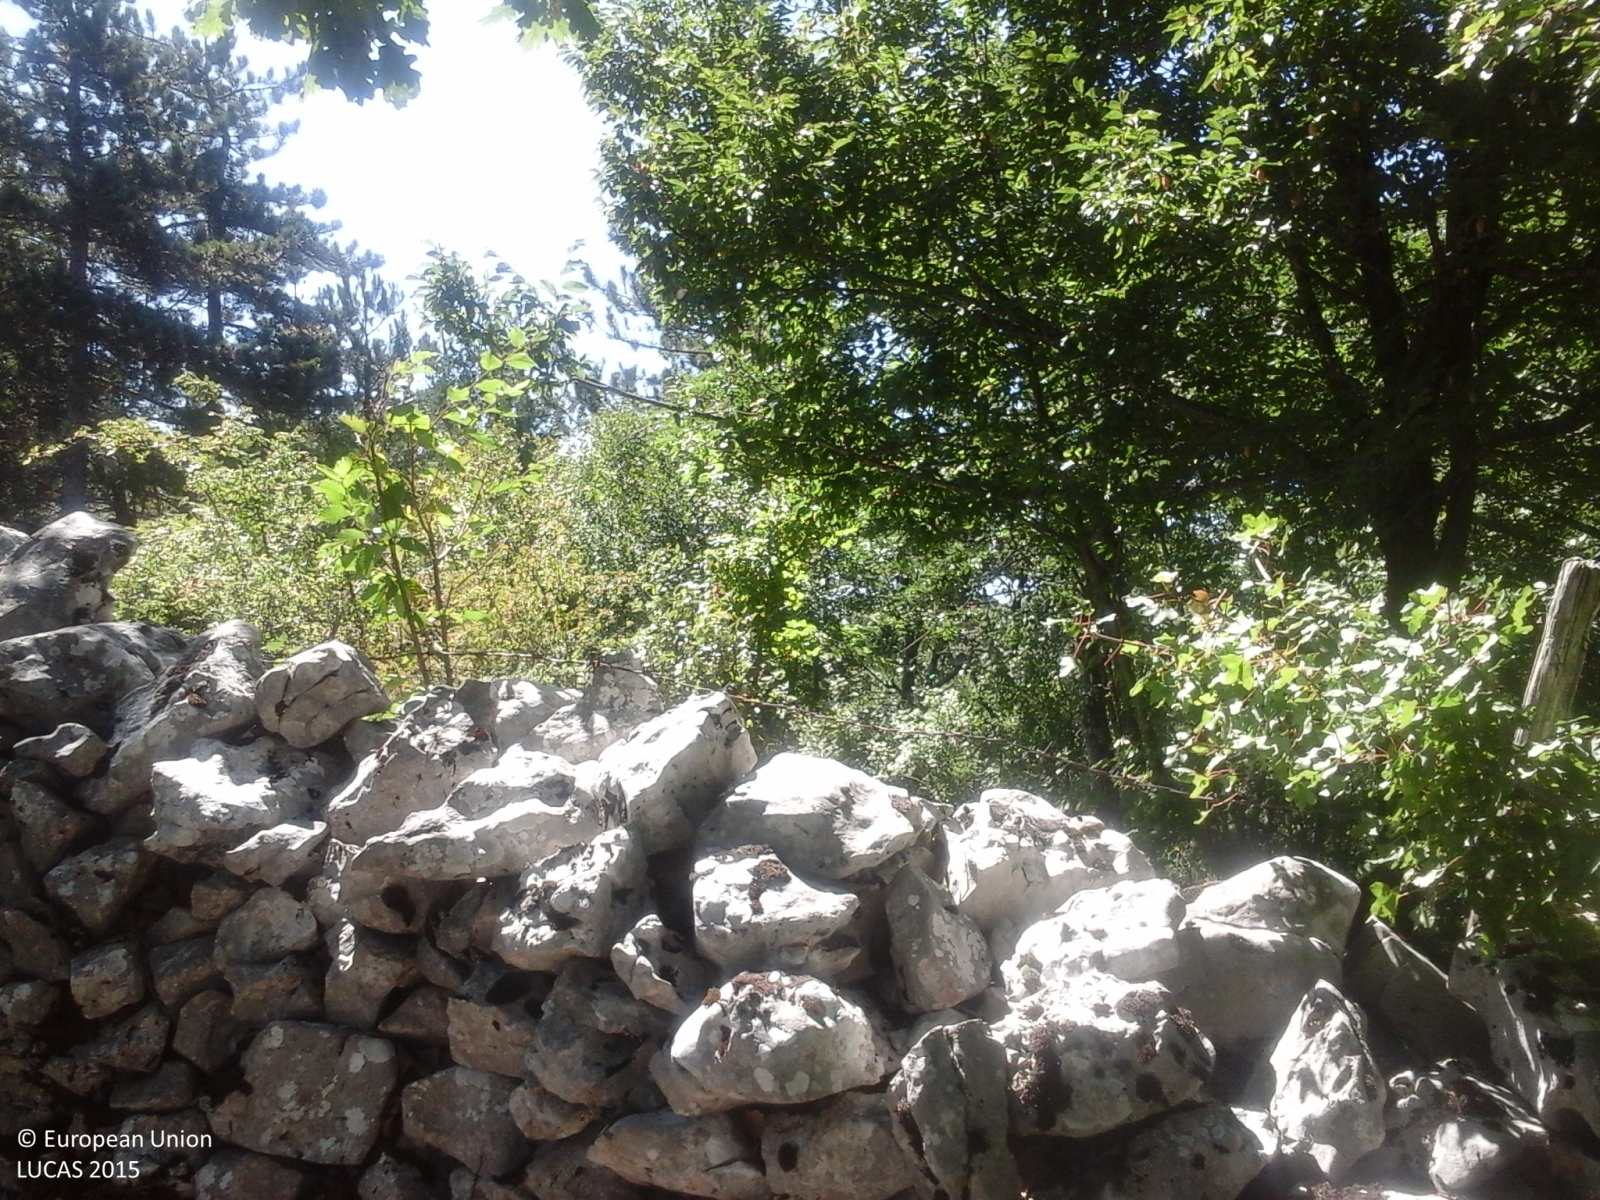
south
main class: Woodland
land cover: Broadleaved woodland
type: thermophilous deciduous forest
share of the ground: 50 - 75 %
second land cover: Grassland without tree/shrub cover
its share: > 75 %
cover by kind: broadleaved forest trees 100 %
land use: Forestry
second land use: Agriculture (excluding fallow land and kitchen gardens)
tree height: < 5 m
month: August
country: IT
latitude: 41.8989
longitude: 13.1828
